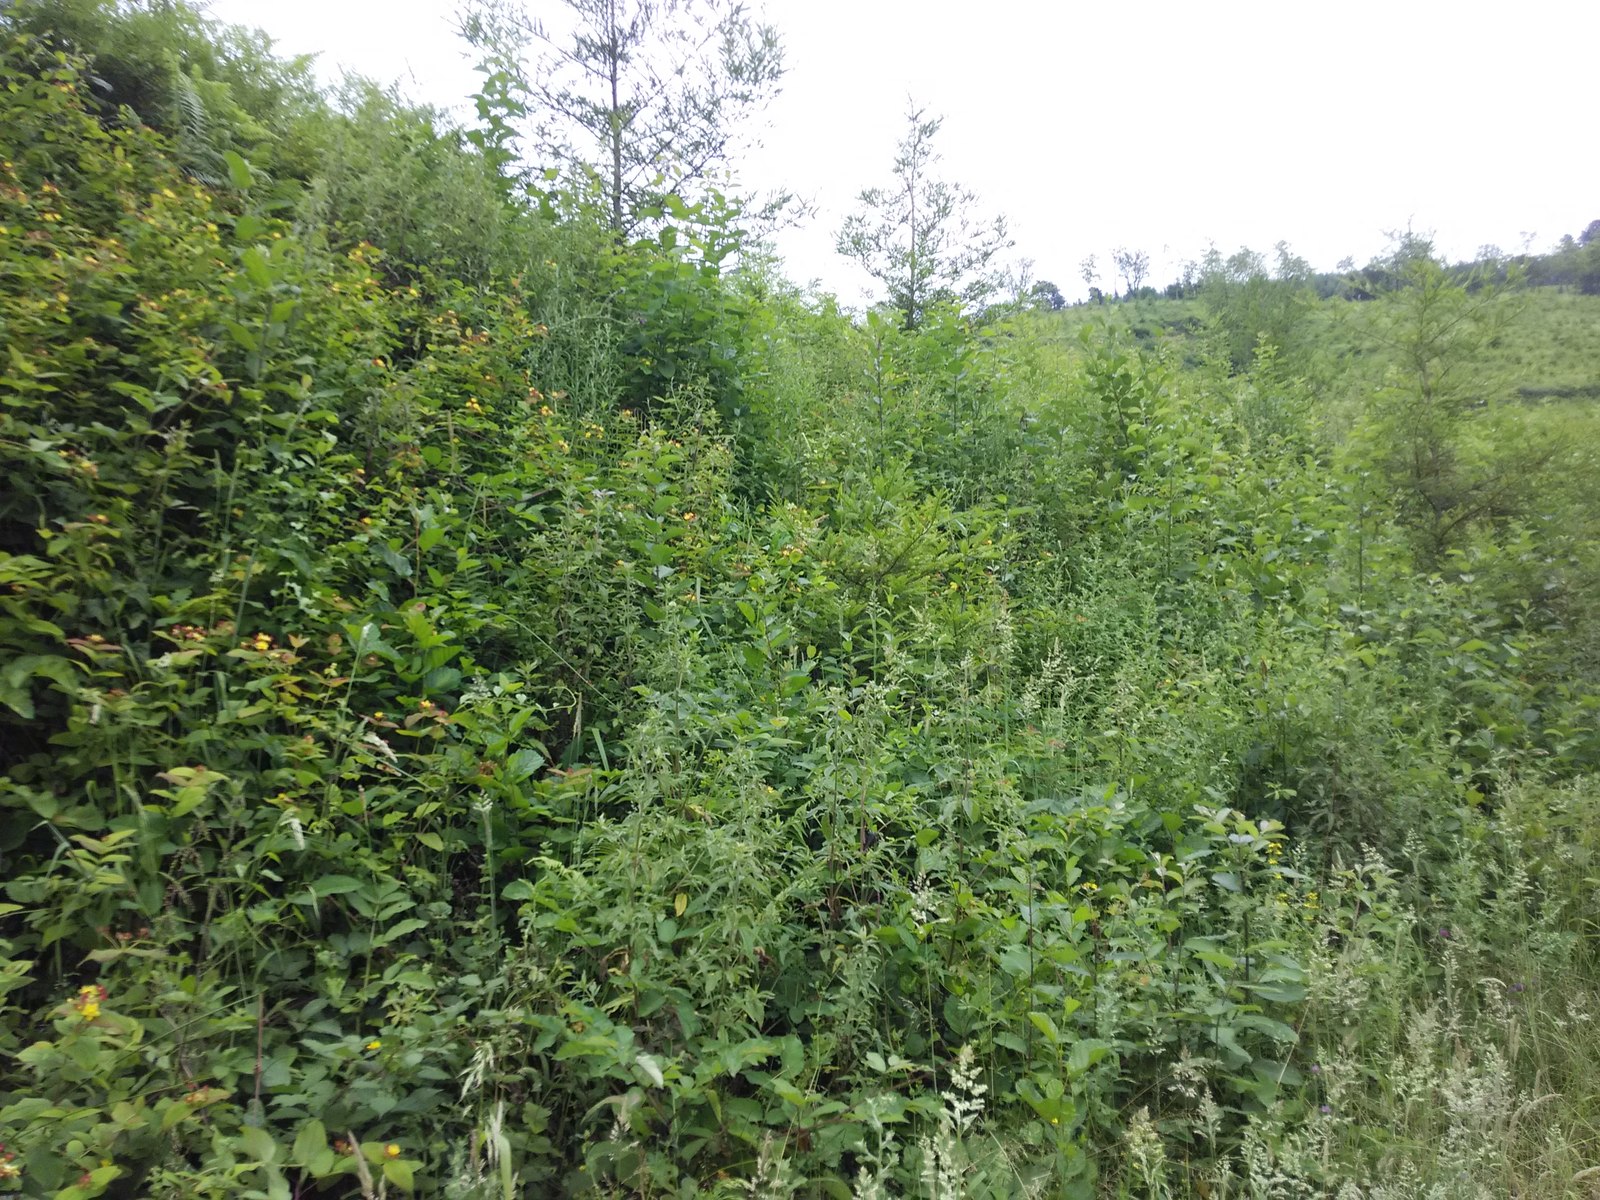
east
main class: Woodland
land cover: Broadleaved woodland
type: floodplain forest
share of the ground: > 75 %
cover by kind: broadleaved forest trees 85 %, coniferous forest trees 10 %, unconsolidated bare surface 5 %
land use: Forestry
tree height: > 5 m
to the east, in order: Broadleaved woodland; Rivers and streams; Broadleaved woodland; Spruce dominated coniferous woodland; Tracks; Spruce dominated coniferous woodland; Electric lines; Spruce dominated coniferous woodland
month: July
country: ES
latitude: 43.0934
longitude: -2.2477
